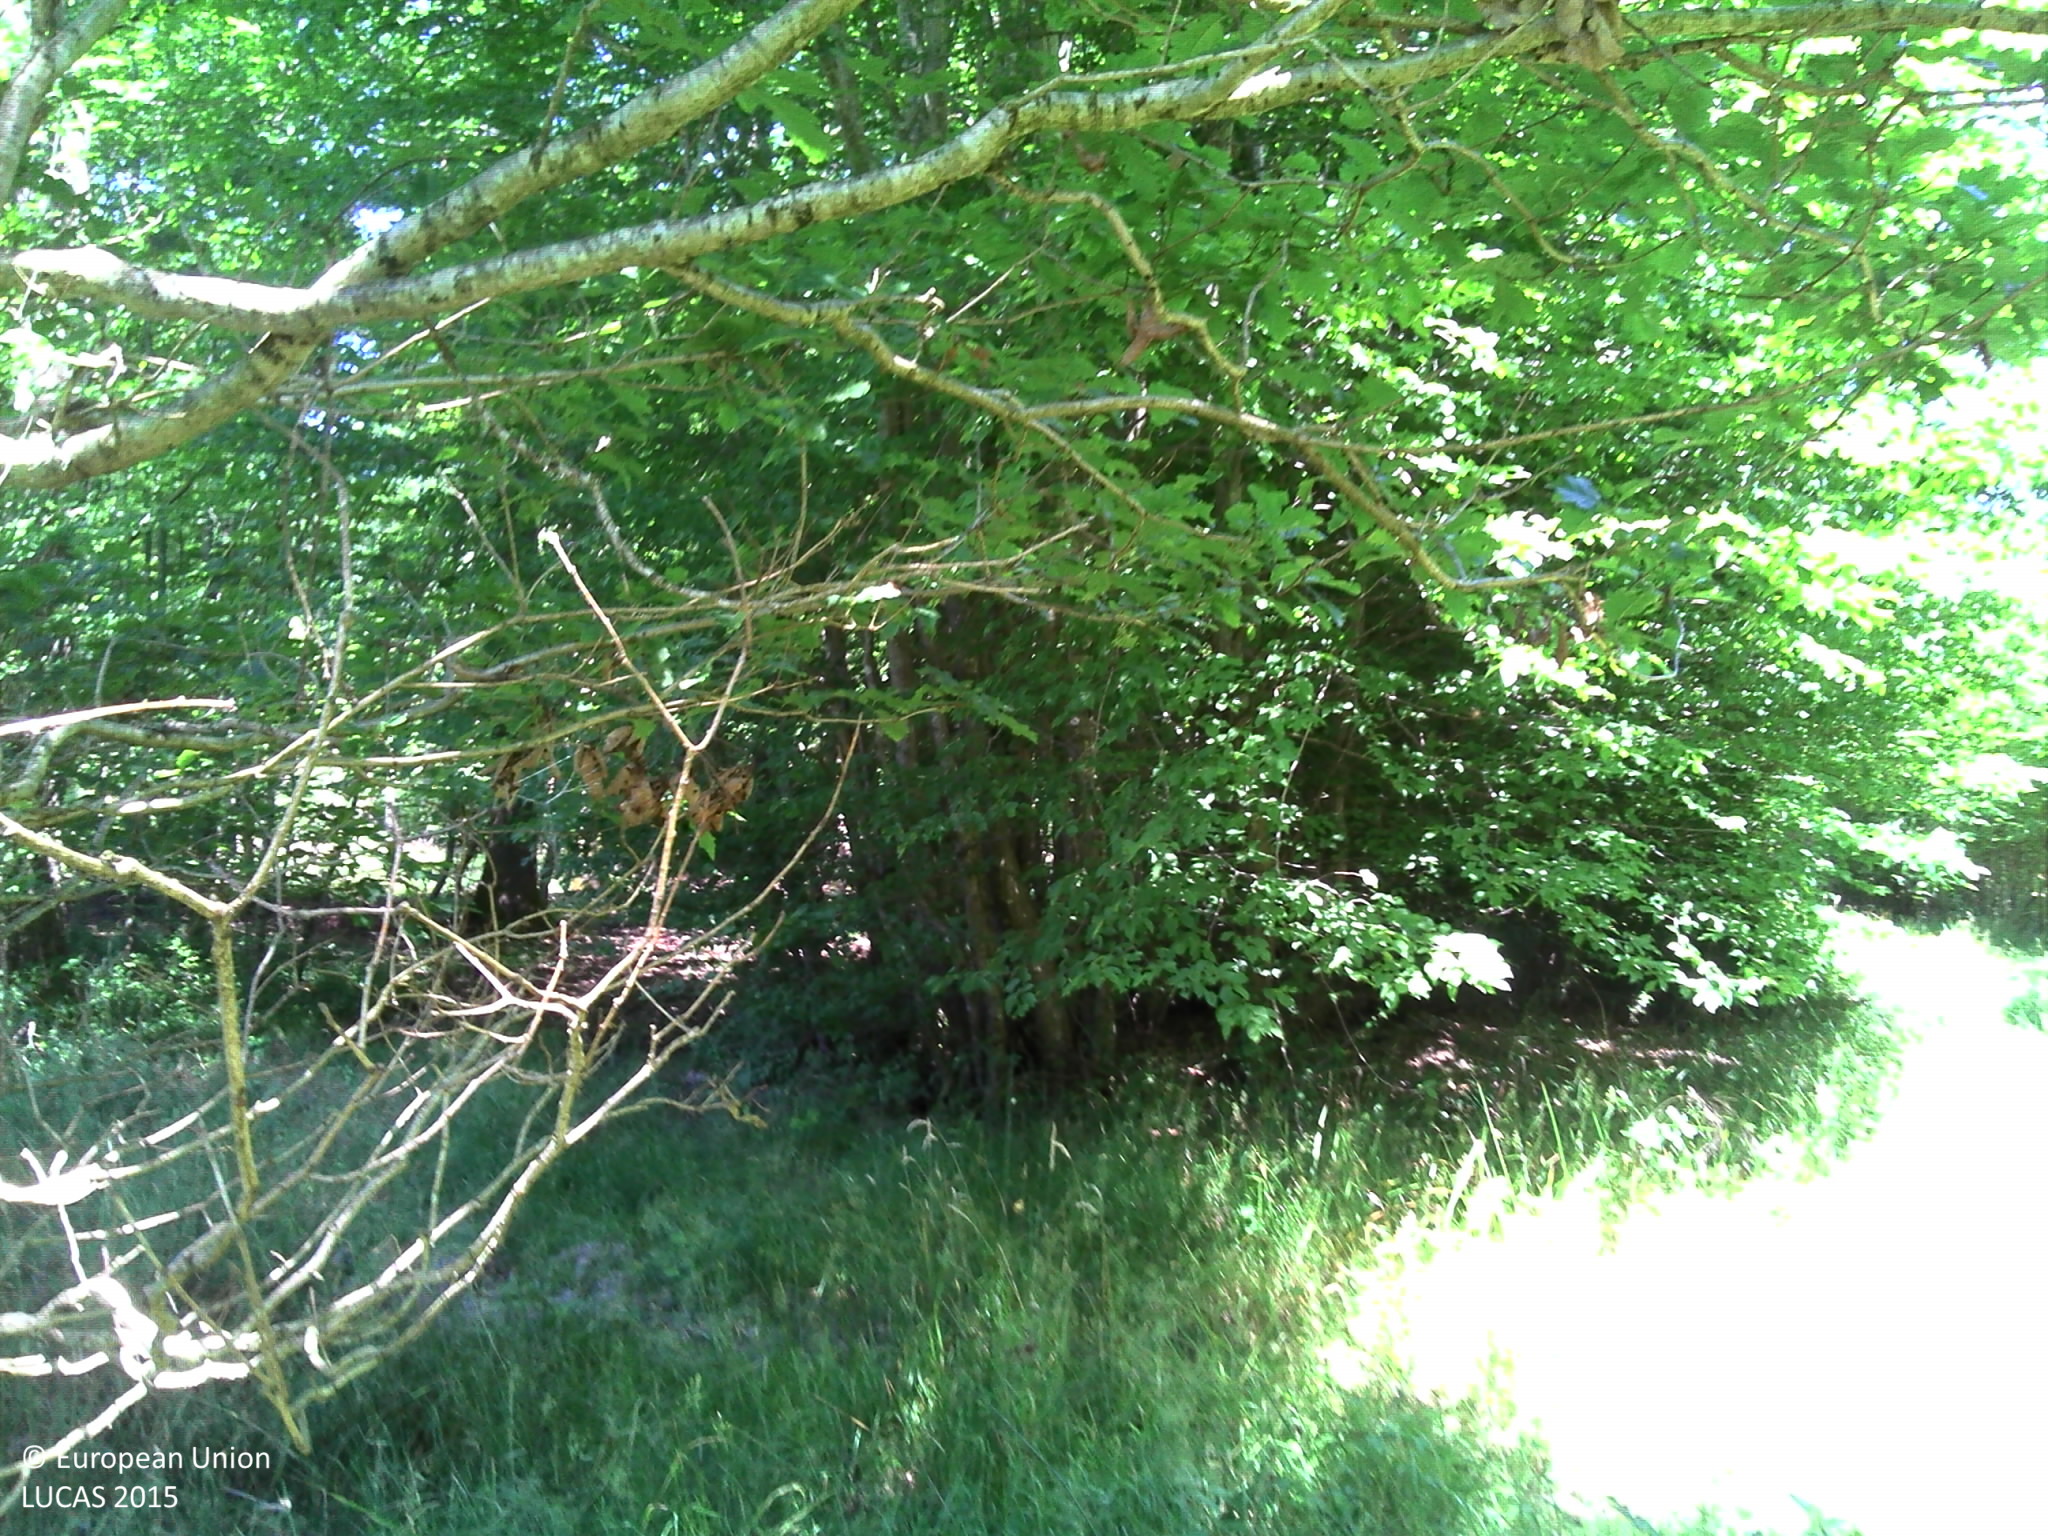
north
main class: Woodland
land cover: Broadleaved woodland
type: mesophytic deciduous forest
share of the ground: > 75 %
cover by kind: broadleaved forest trees 90 %, herbaceous plants 10 %
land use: Forestry
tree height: > 5 m
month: June
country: FR
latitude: 46.1985
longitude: 3.3514
